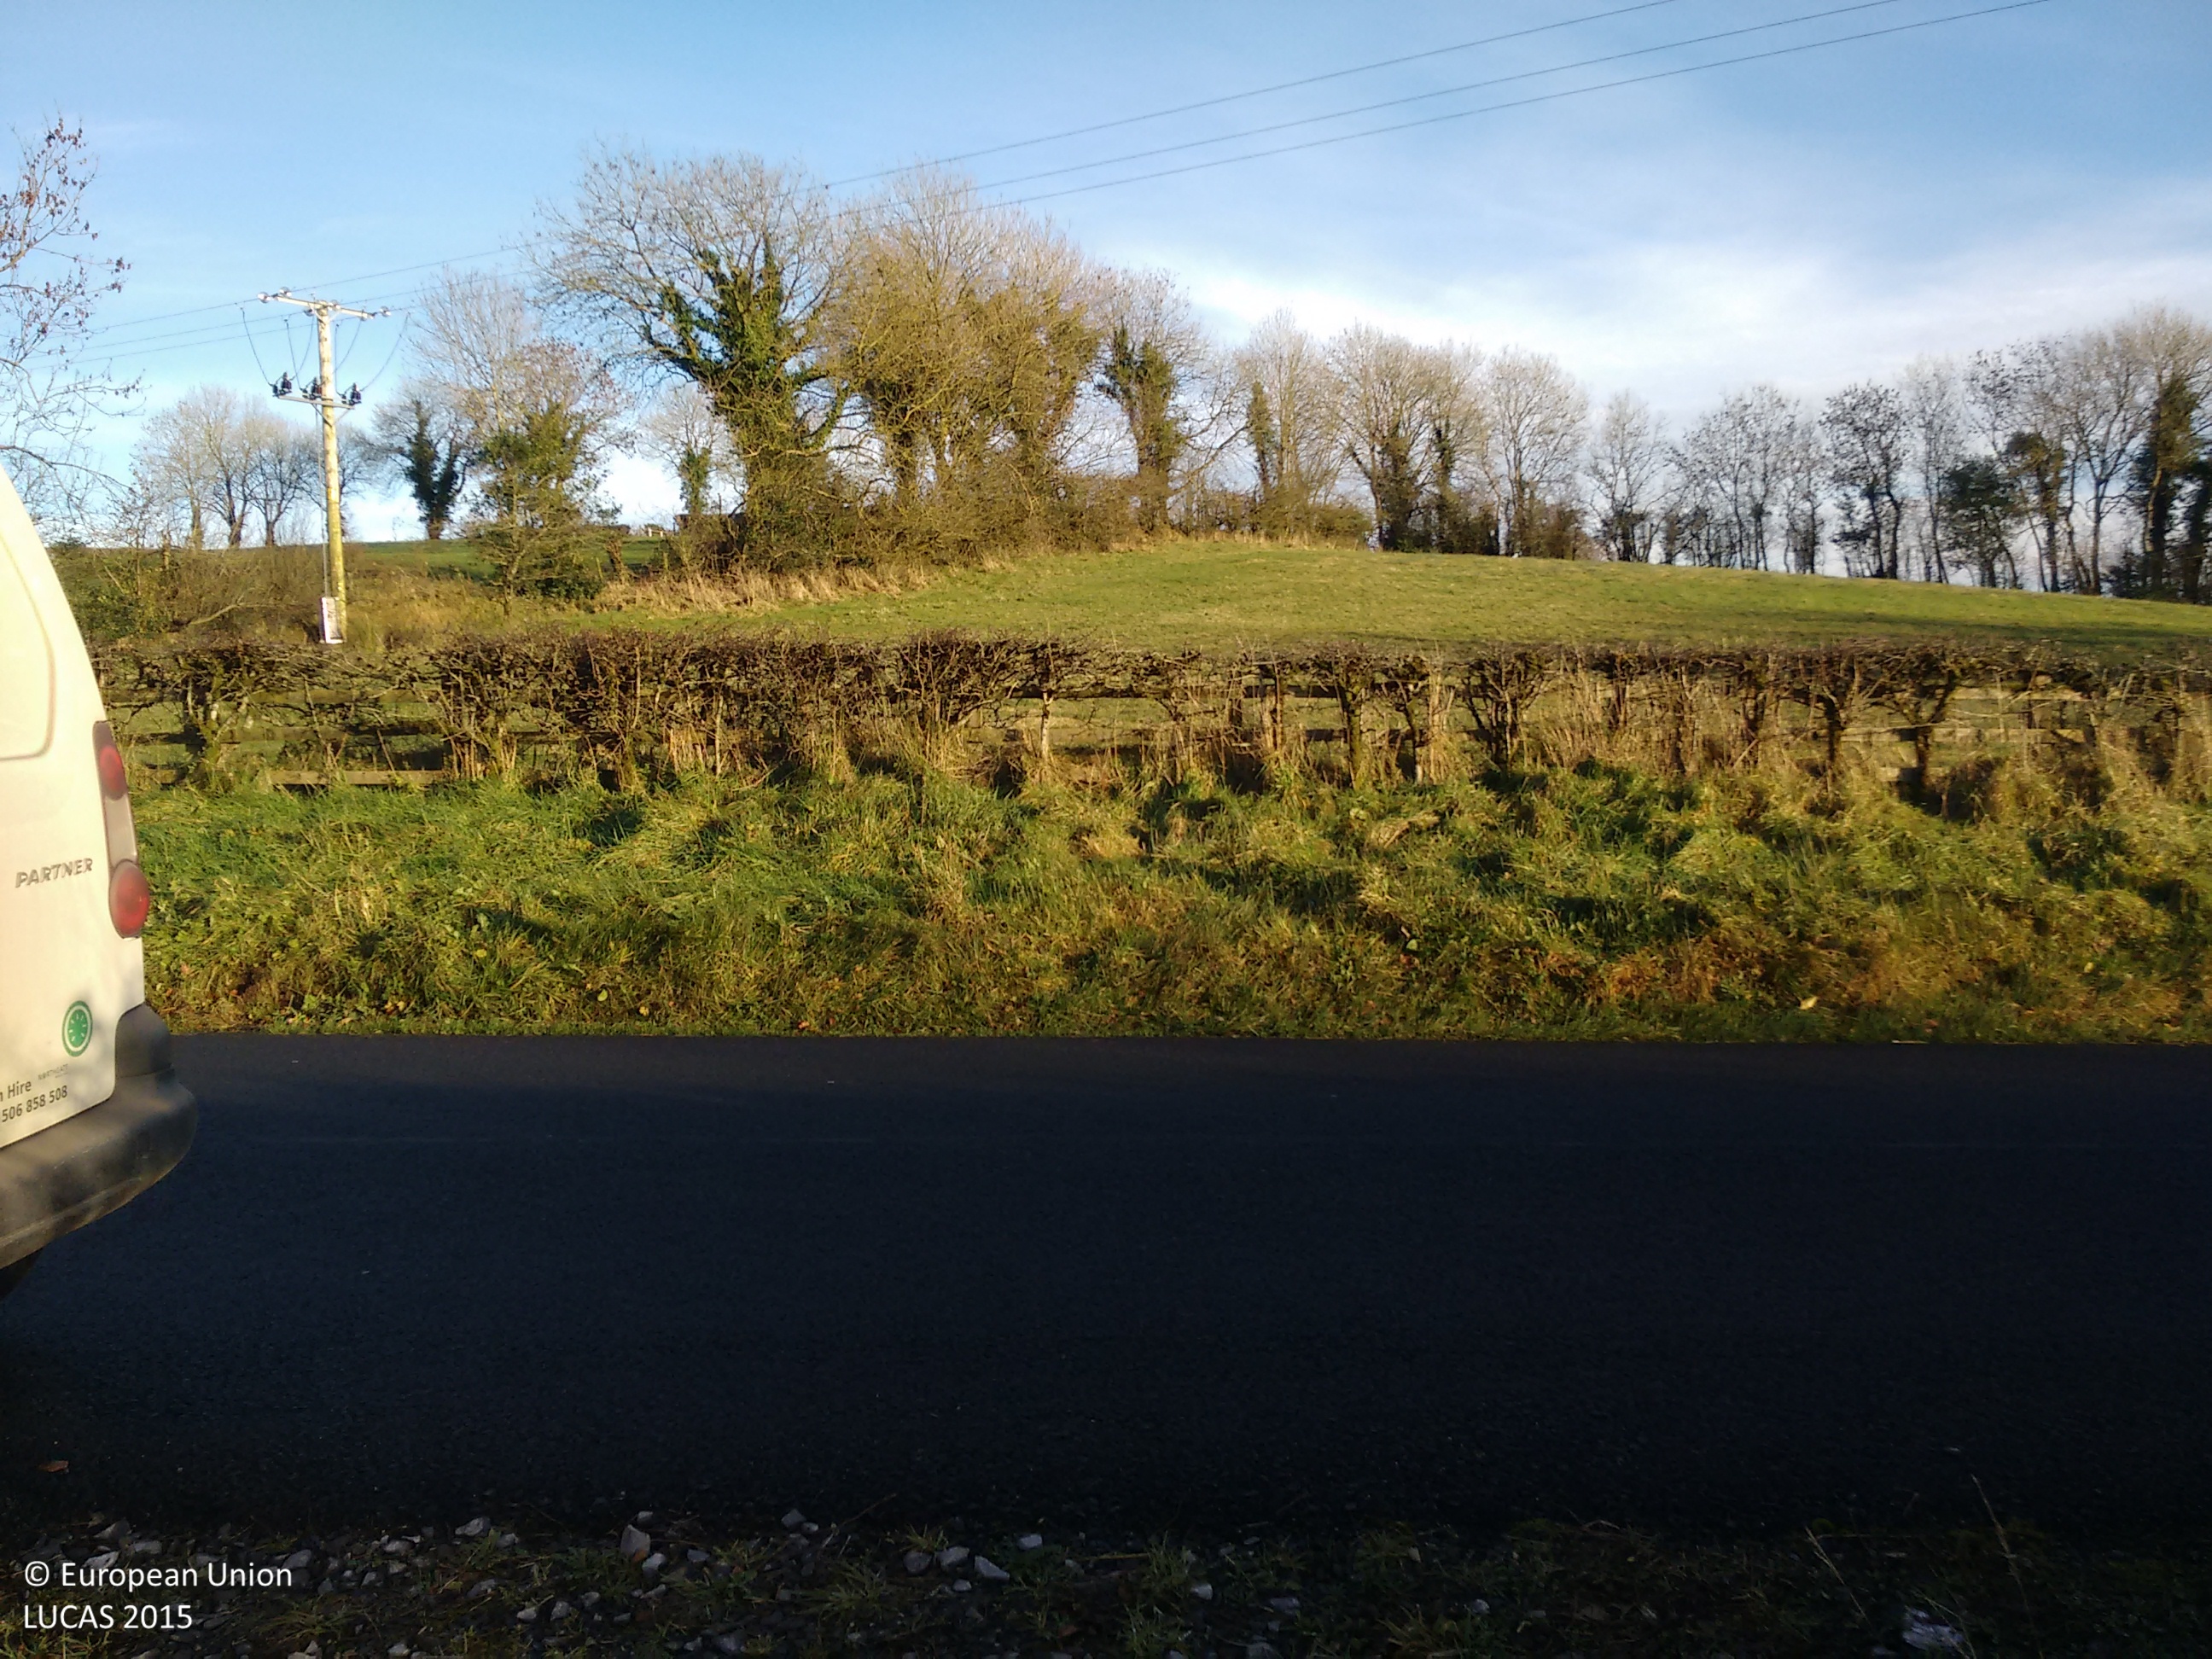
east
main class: Grassland
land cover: Grassland without tree/shrub cover
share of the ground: > 75 %
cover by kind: herbaceous plants 100 %
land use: Agriculture (excluding fallow land and kitchen gardens)
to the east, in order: Grassland without tree/shrub cover; Fences; Grass margins; Ditches and canals; Grass margins; Fences; Grassland without tree/shrub cover; Managed hedges; Grass margins; Paved roads, cycling and walking lanes; Grass margins; Electric lines; Managed hedges; Fences; Grassland without tree/shrub cover; Fences; Broadleaved woodland; Grassland without tree/shrub cover; Artificial constructions in urban areas; Arable land (only in case pi)
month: December
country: GB
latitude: 54.3353
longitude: -7.2978
